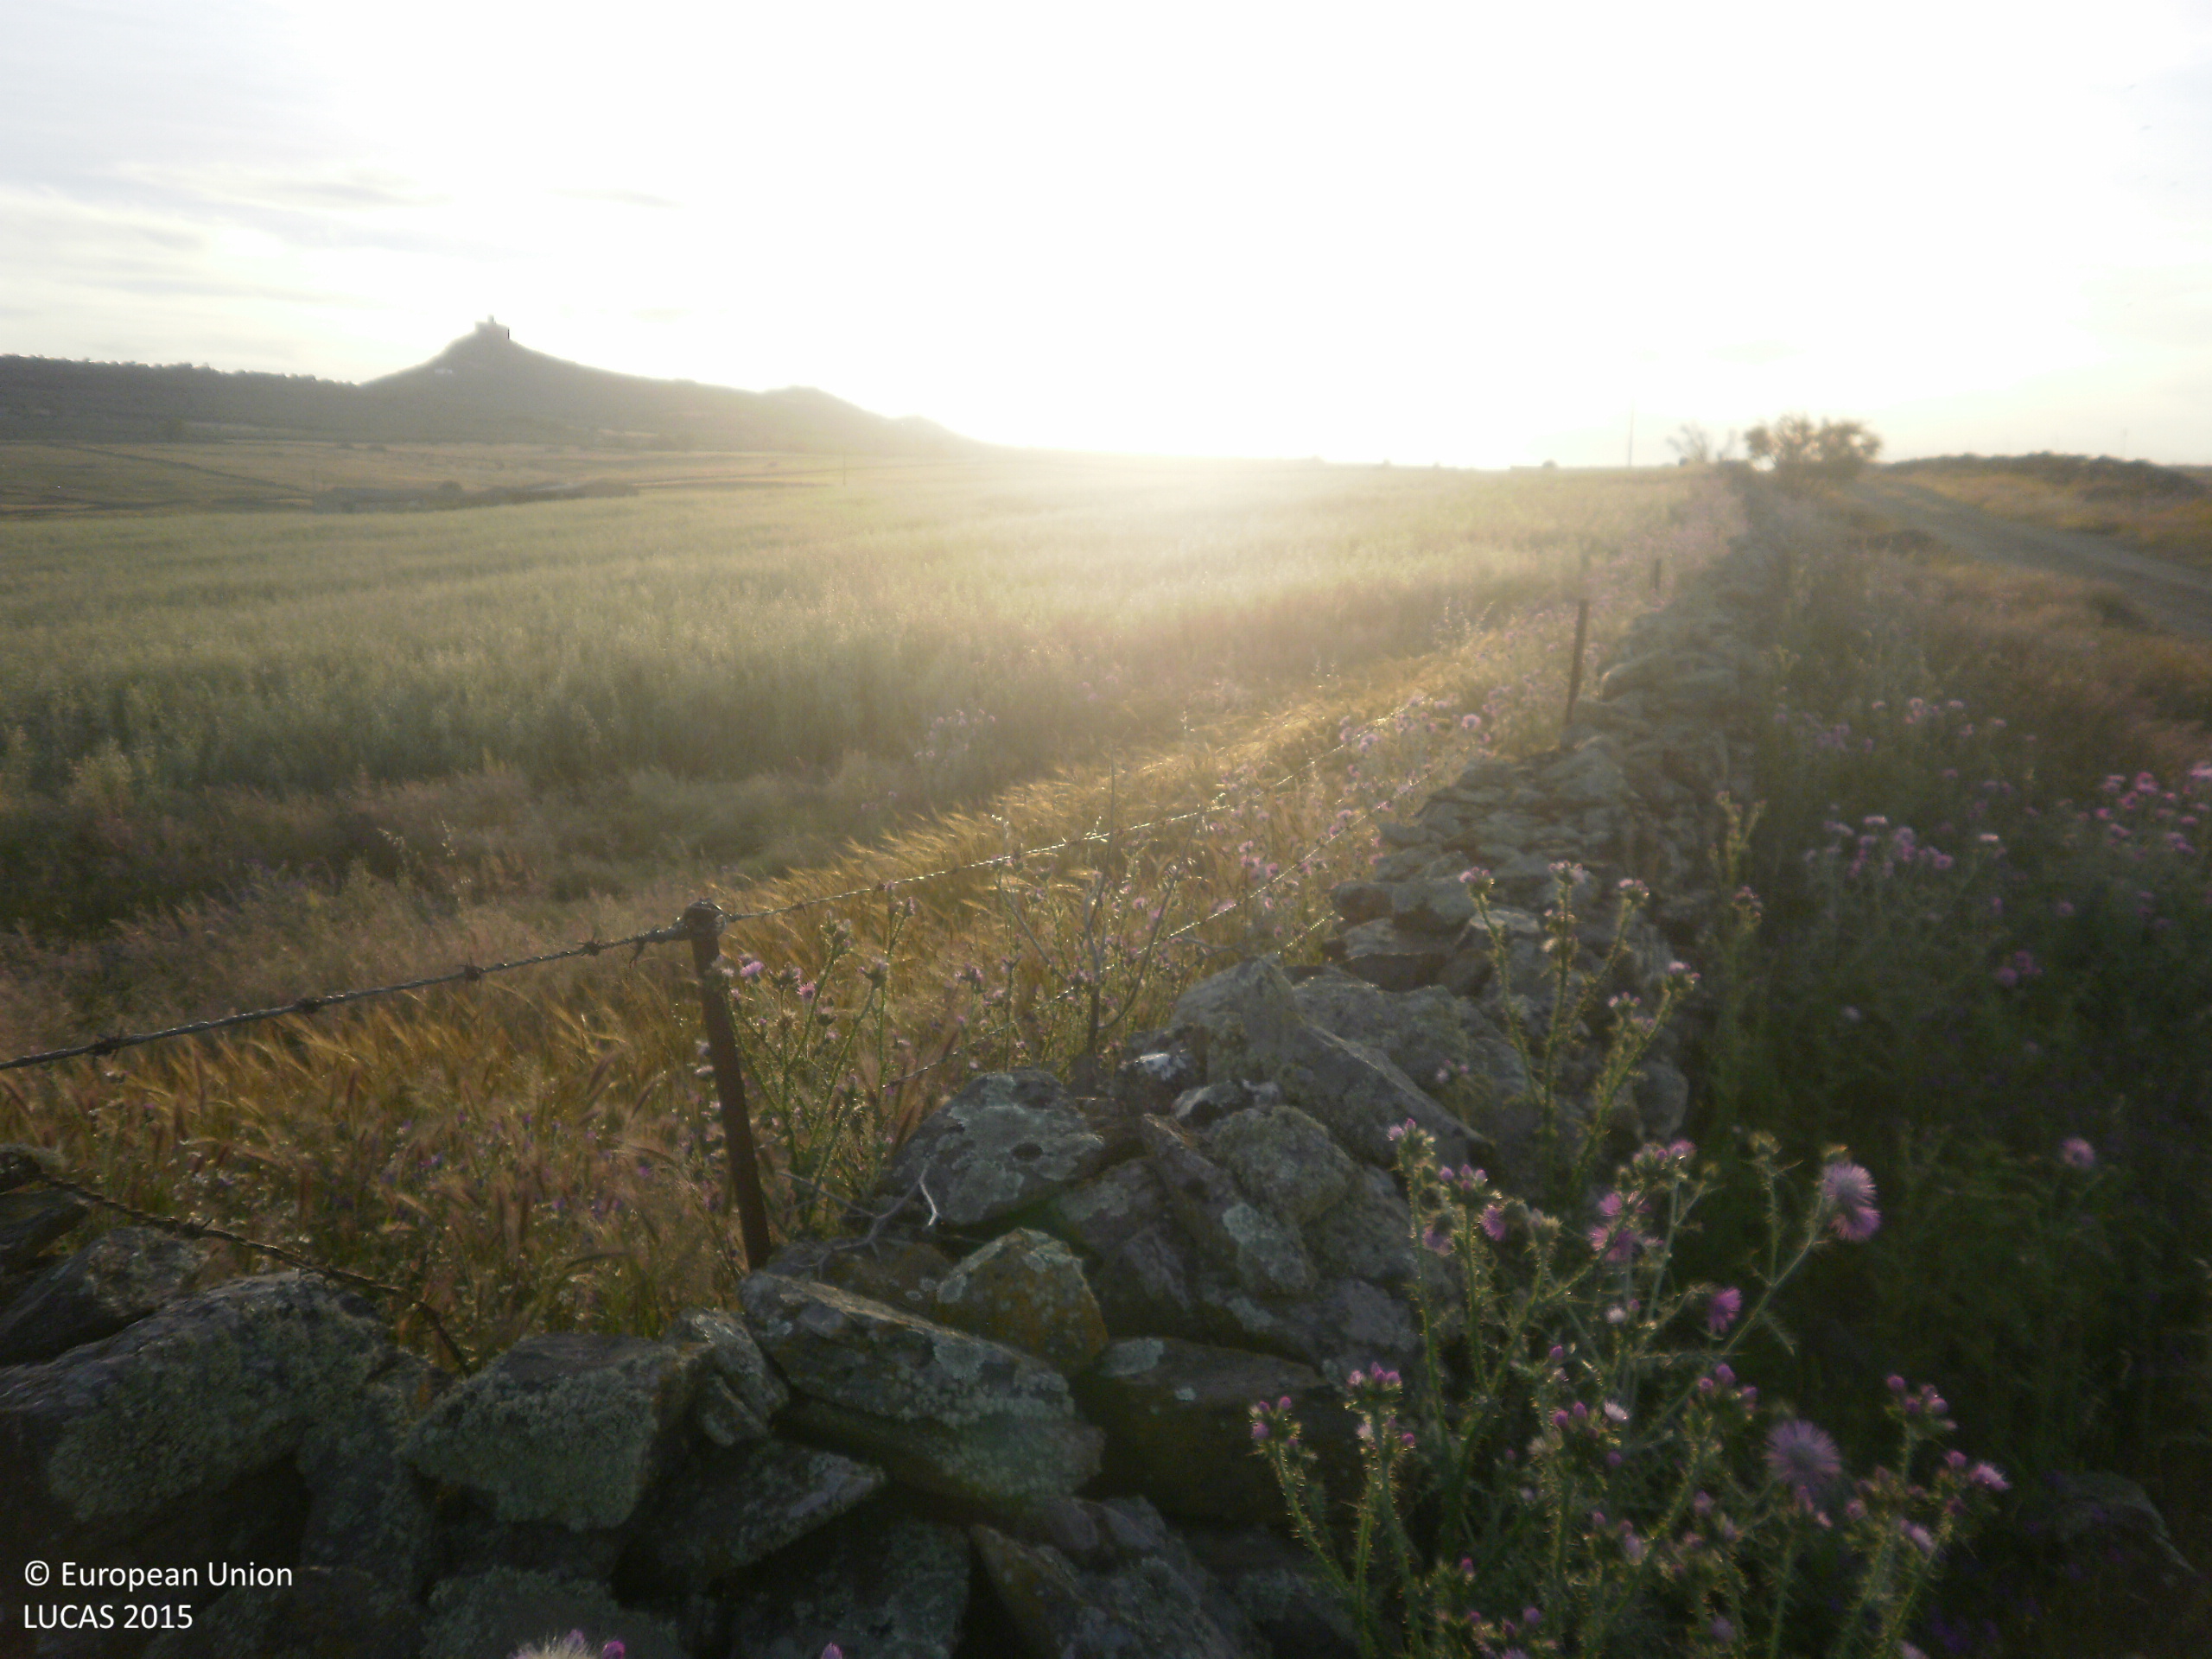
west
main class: Grassland
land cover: Grassland without tree/shrub cover
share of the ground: > 75 %
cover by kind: herbaceous plants 100 %
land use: Agriculture (excluding fallow land and kitchen gardens)
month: April
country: ES
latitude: 38.9804
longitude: -5.2185
